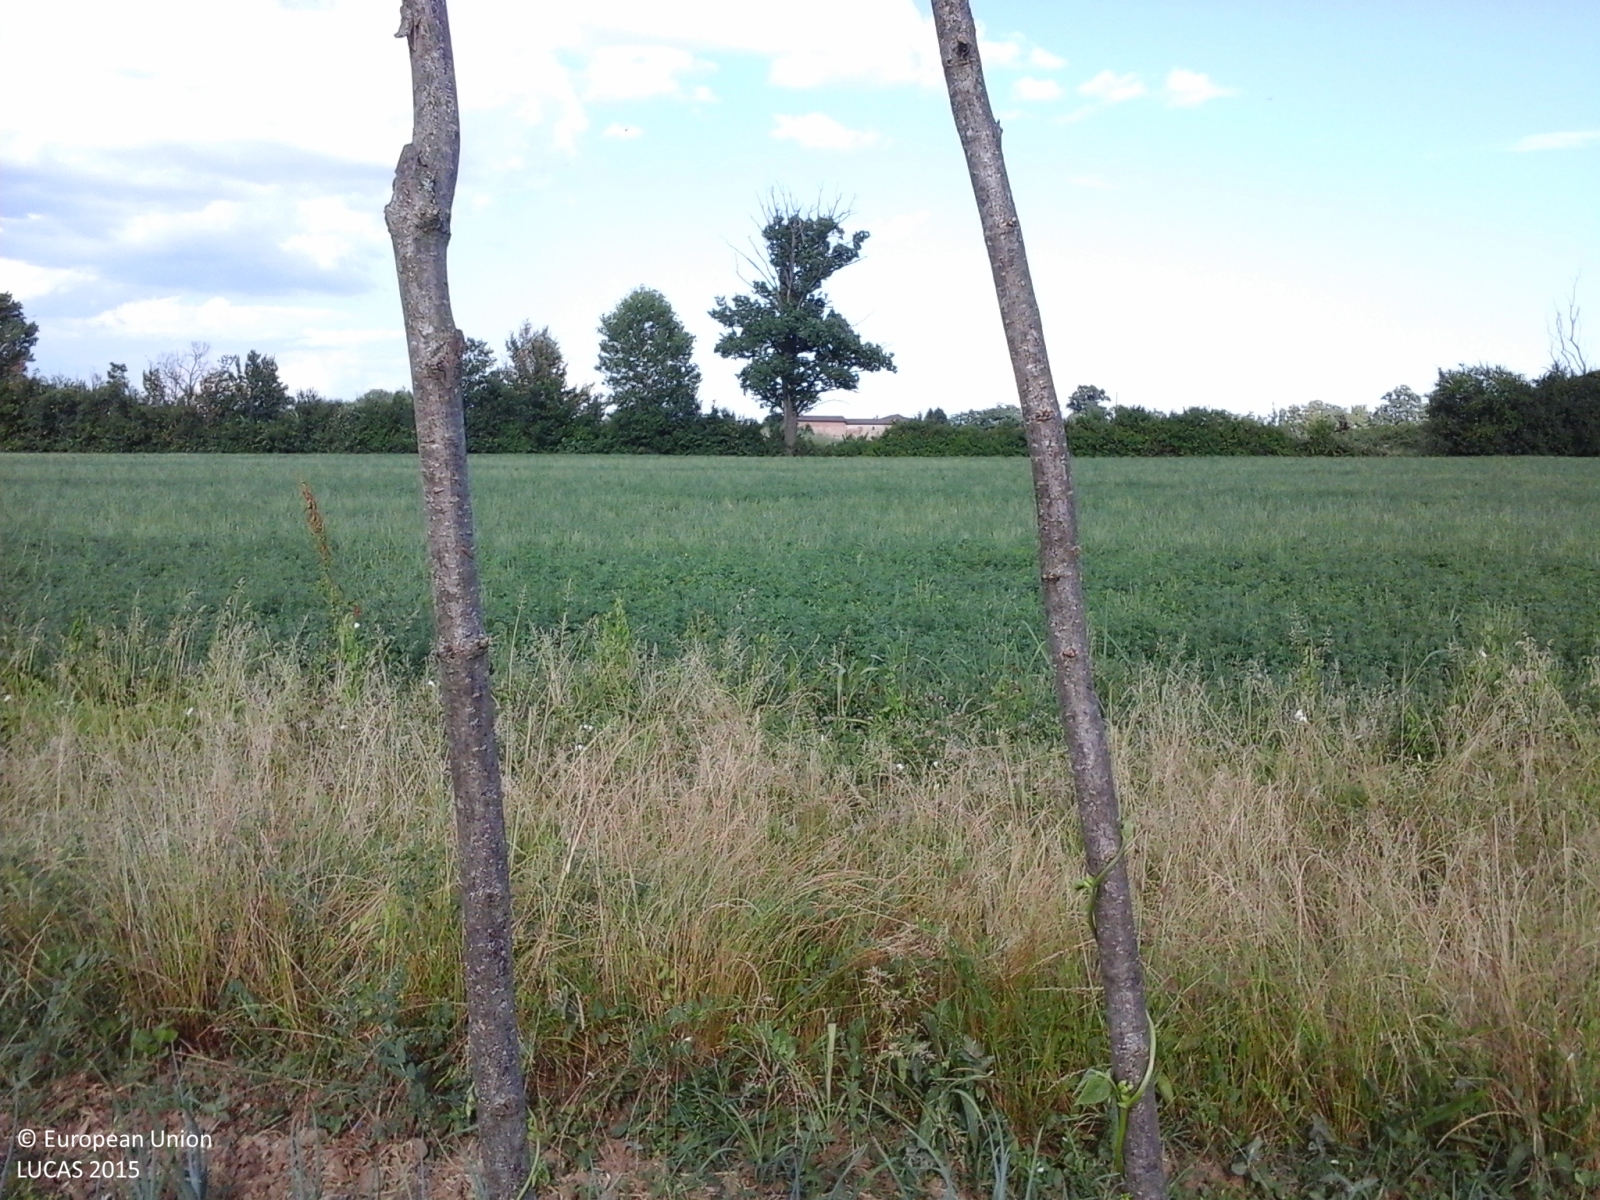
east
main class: Cropland
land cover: Other fresh vegetables
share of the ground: < 10 %
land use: Kitchen garden
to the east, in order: Other fresh vegetables; Grassland without tree/shrub cover; Lucerne; Ditches and canals; Managed hedges; Grassland without tree/shrub cover; Inland fresh water bodies; Grassland without tree/shrub cover; Ditches and canals; Common wheat; Ditches and canals; Common wheat
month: June
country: IT
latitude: 44.9095
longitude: 9.8610
